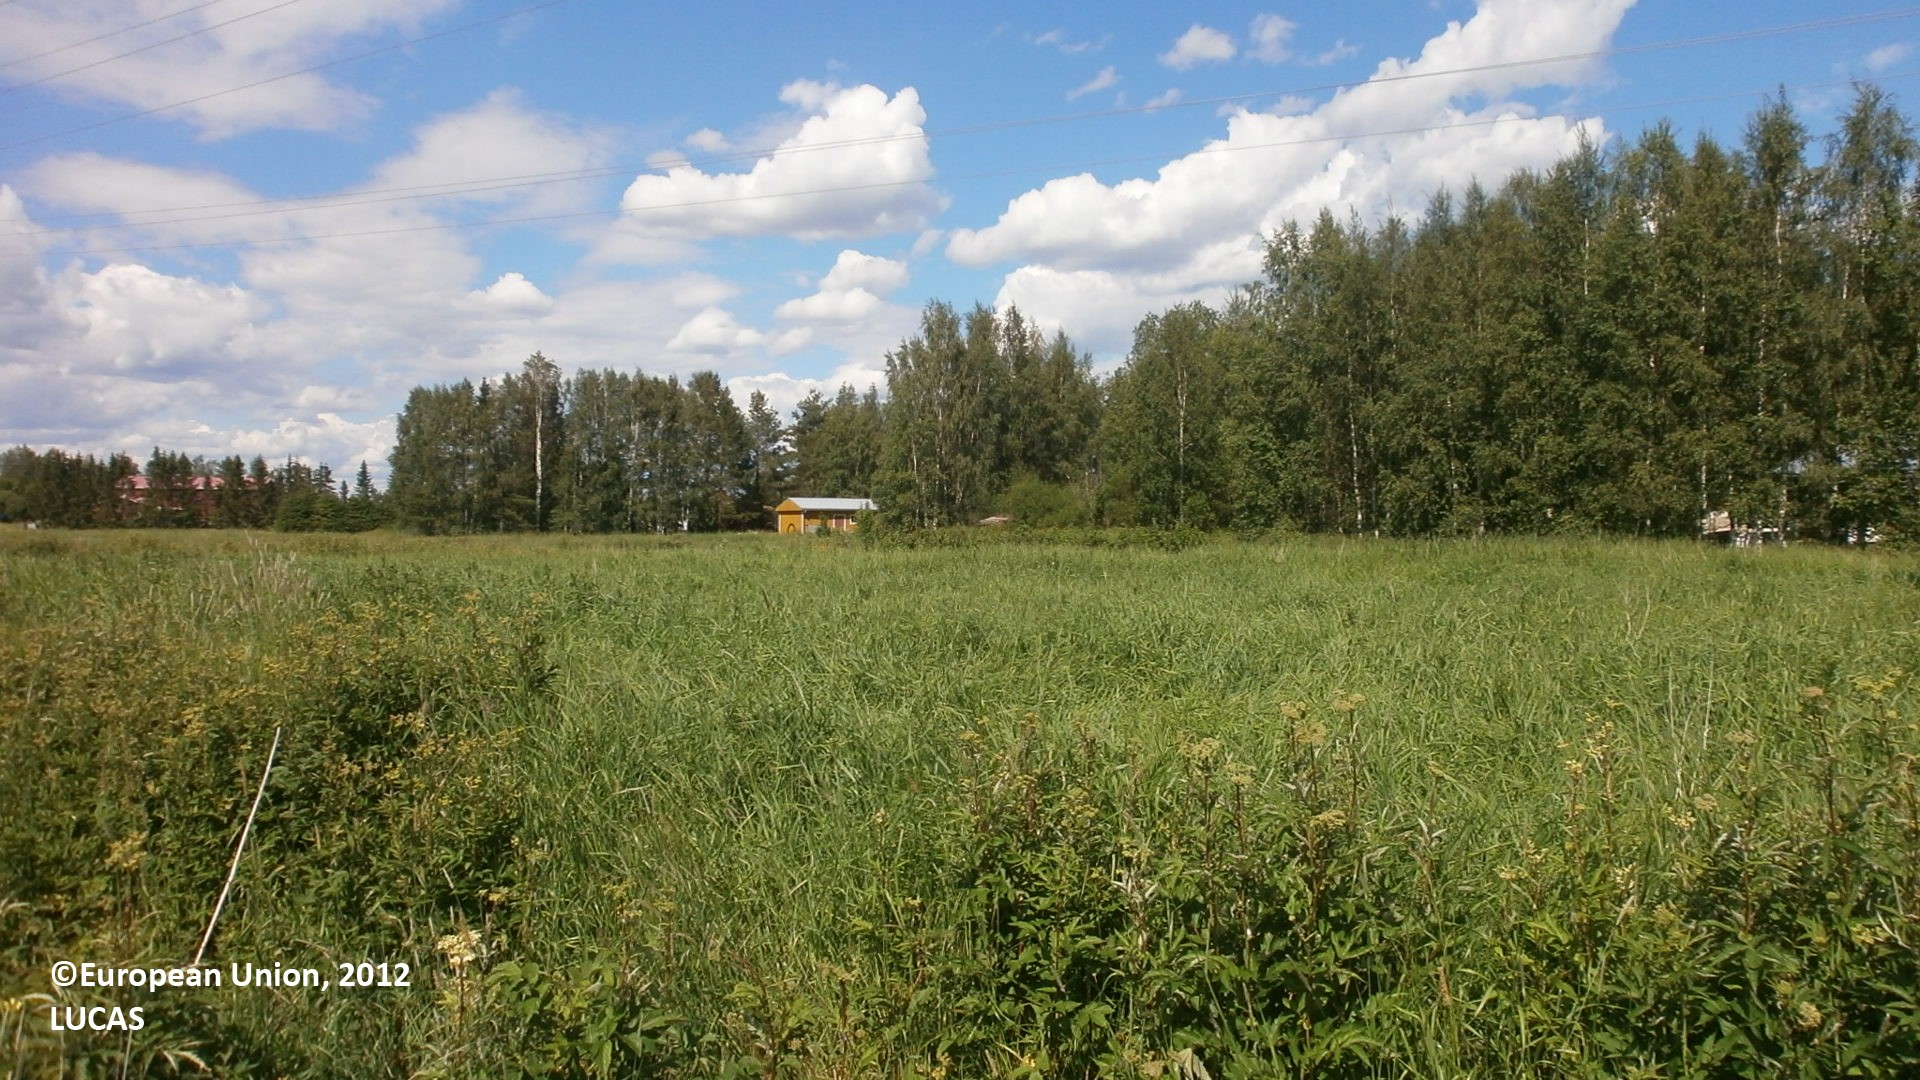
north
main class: Cropland
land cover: Barley
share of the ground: 25 - 50 %
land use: Agriculture (excluding fallow land and kitchen gardens)
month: July
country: FI
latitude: 63.9959
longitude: 24.7787
